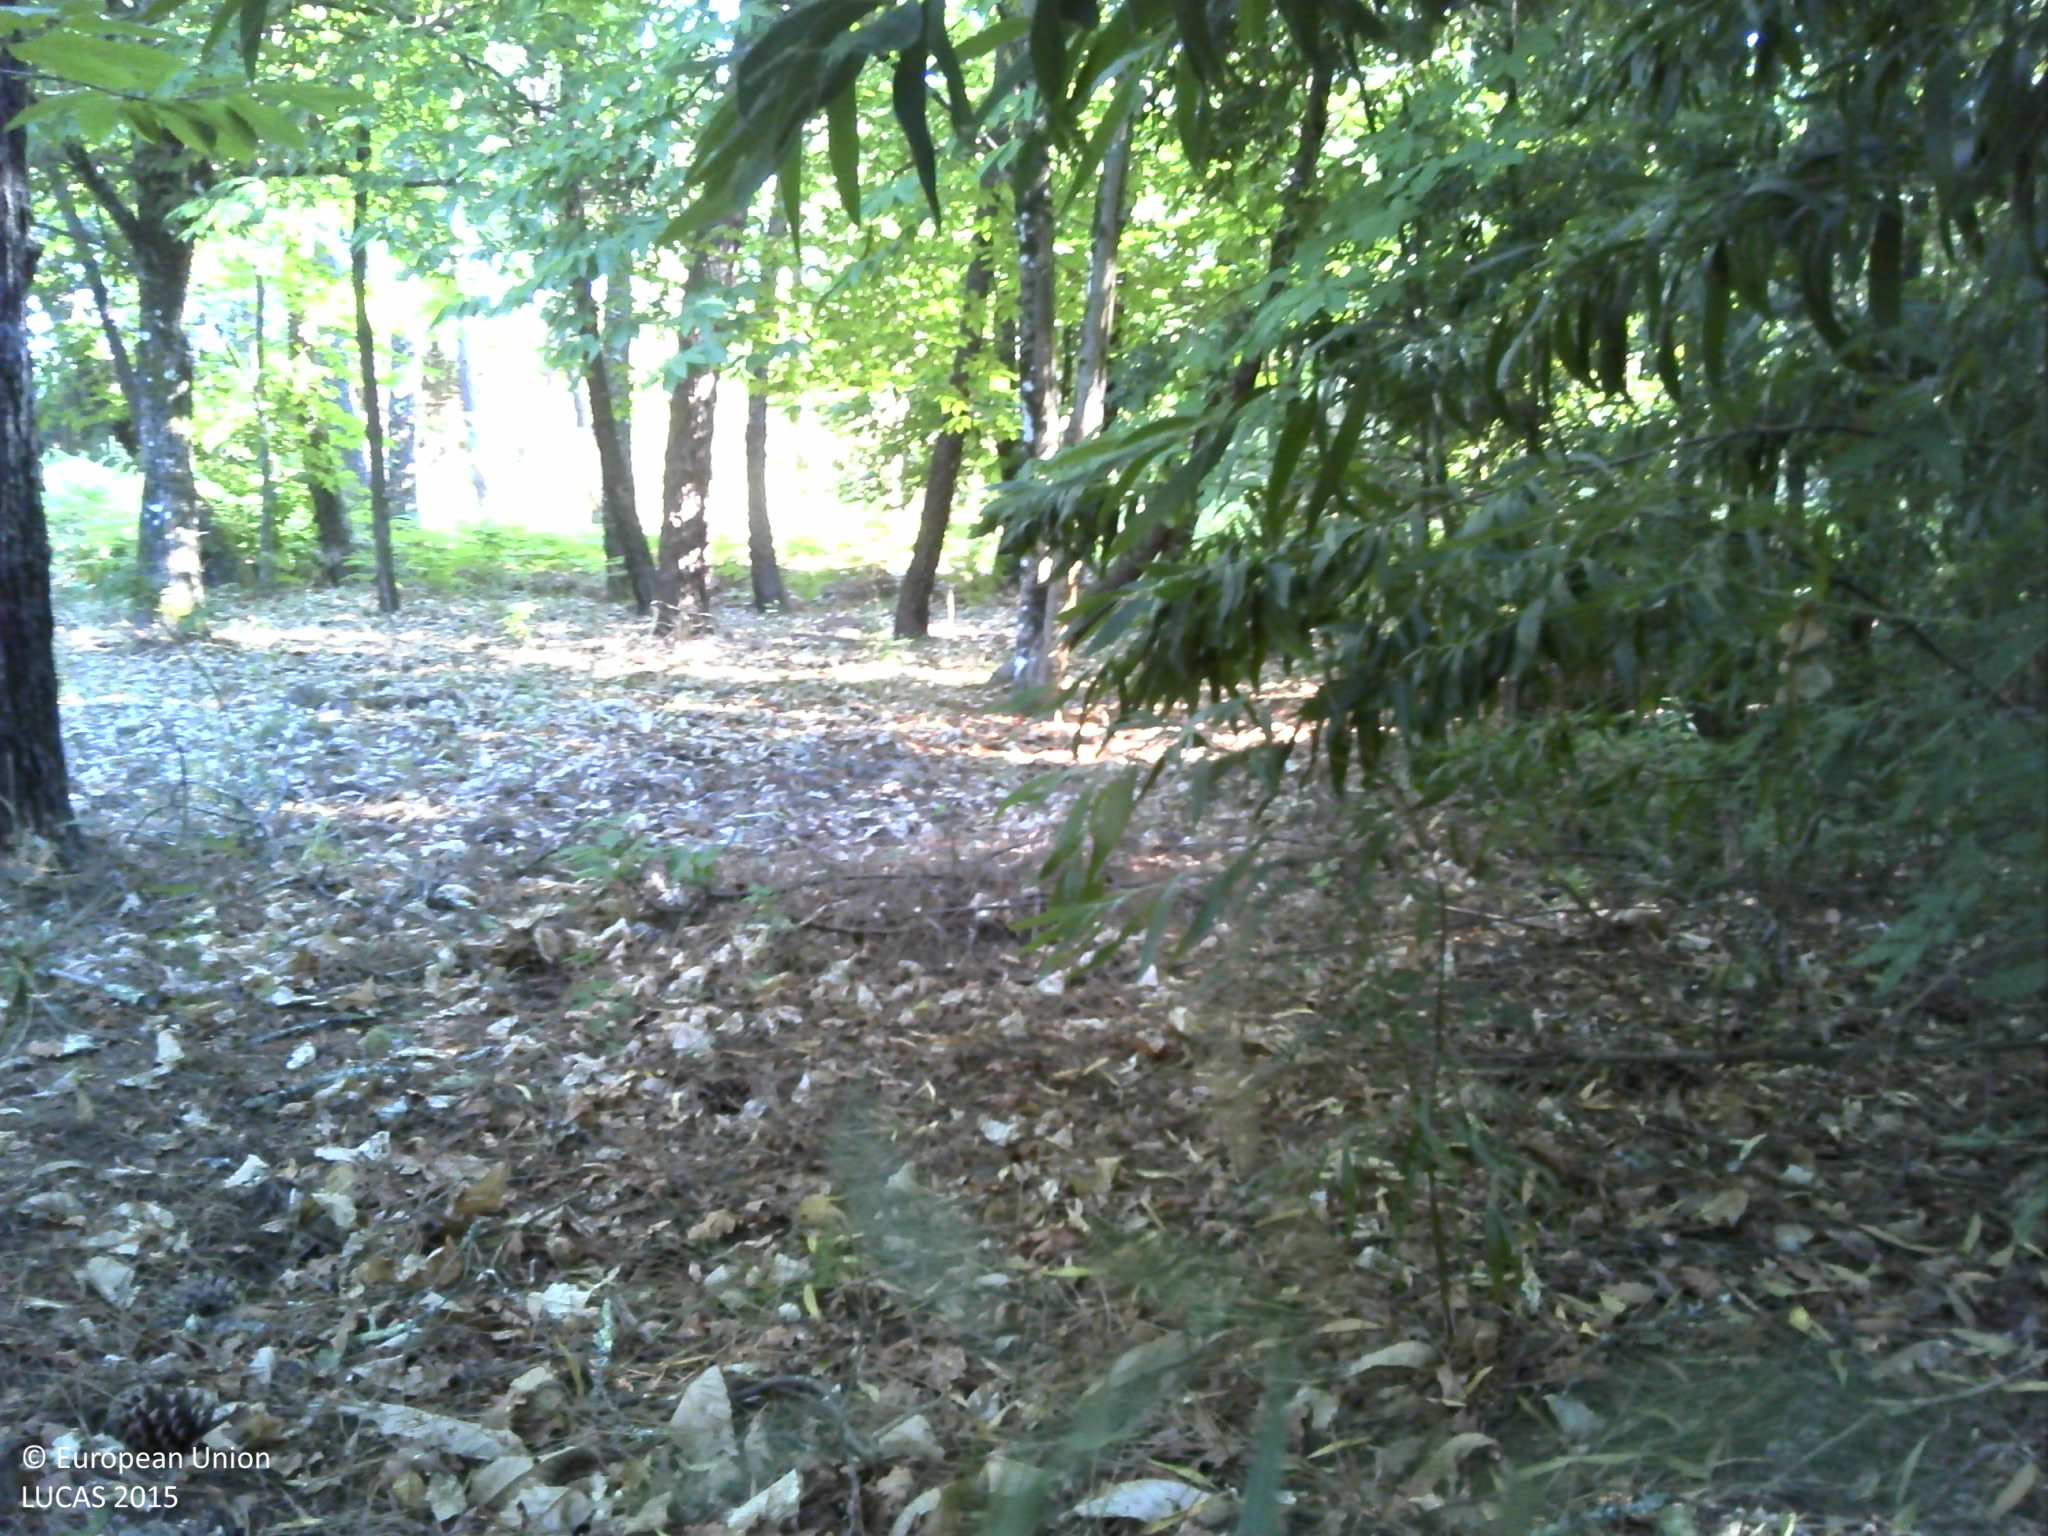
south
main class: Woodland
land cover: Broadleaved woodland
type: thermophilous deciduous forest
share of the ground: 10 - 25 %
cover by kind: broadleaved forest trees 75 %, unconsolidated bare surface 20 %, shrubs 5 %
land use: Forestry
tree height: > 5 m
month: July
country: PT
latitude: 40.7125
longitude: -7.7951
